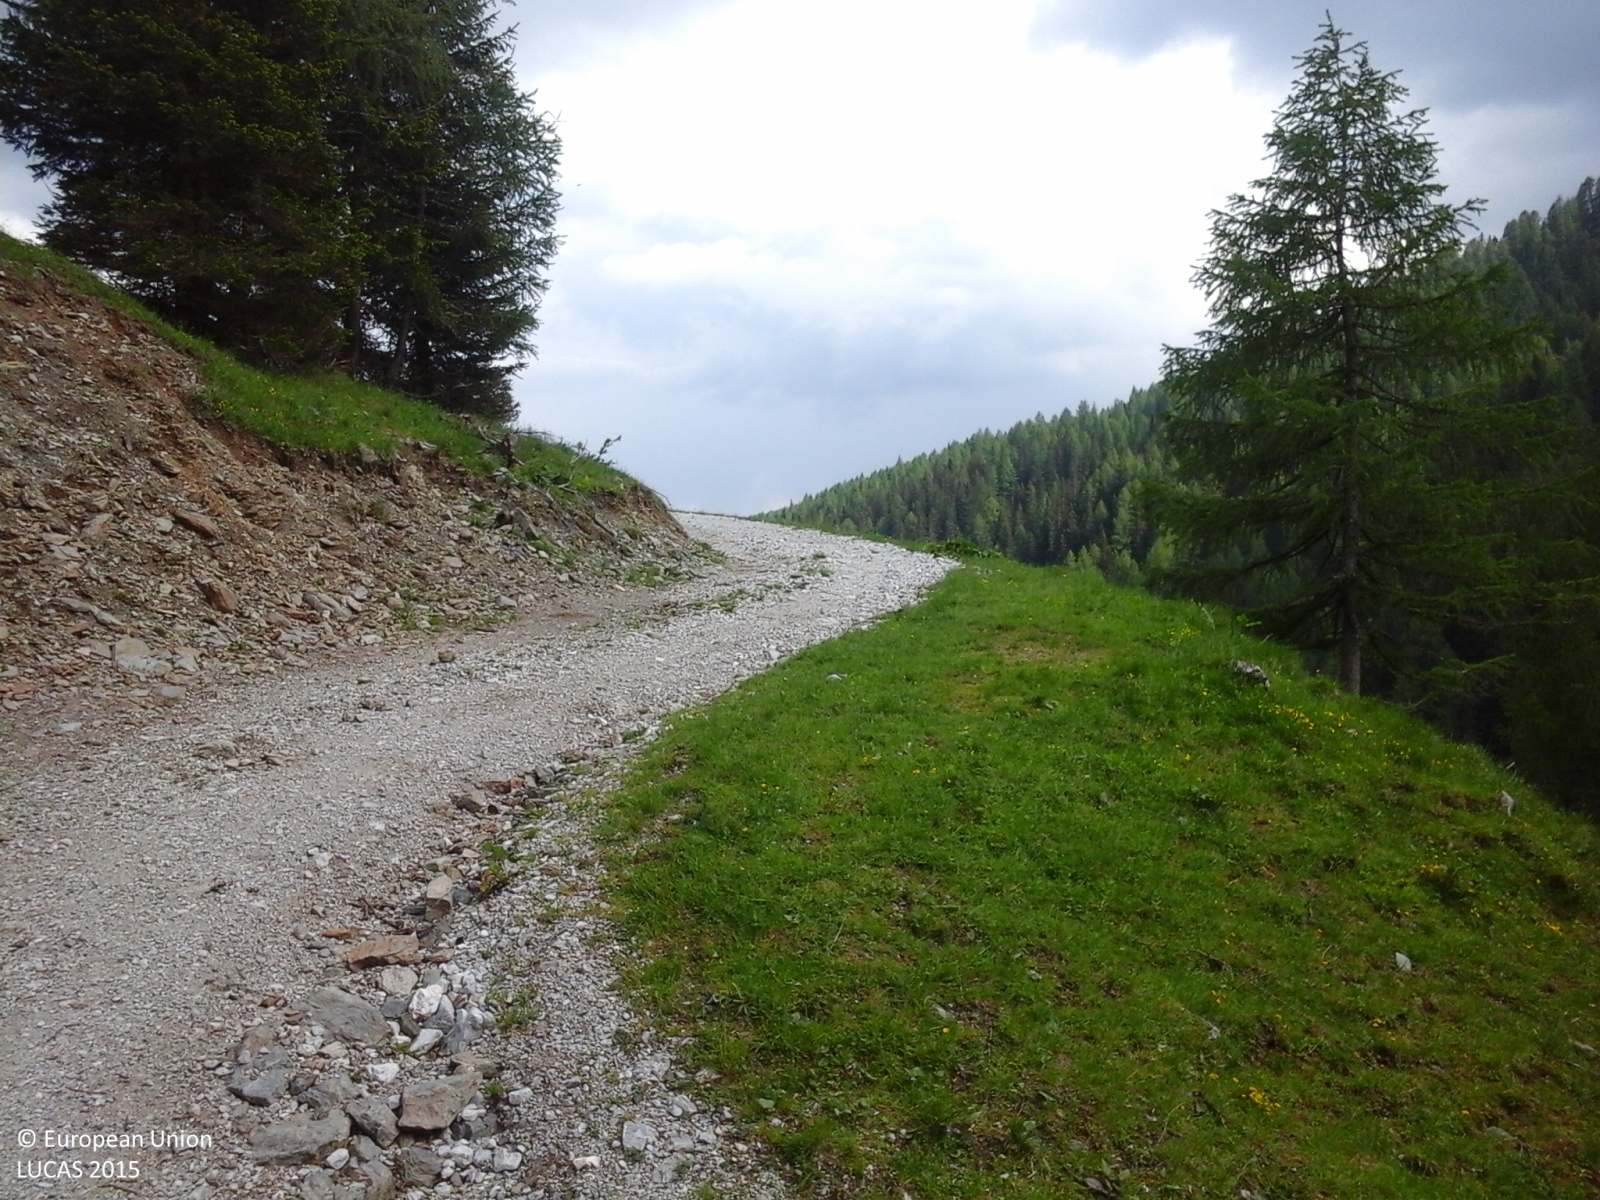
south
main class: Woodland
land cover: Spruce dominated coniferous woodland
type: alpine coniferous forest
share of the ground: > 75 %
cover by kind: herbaceous plants 80 %, coniferous forest trees 15 %, shrubs 5 %
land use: Semi-natural and natural areas not in use
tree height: > 5 m
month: June
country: IT
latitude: 46.6645
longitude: 12.4938
